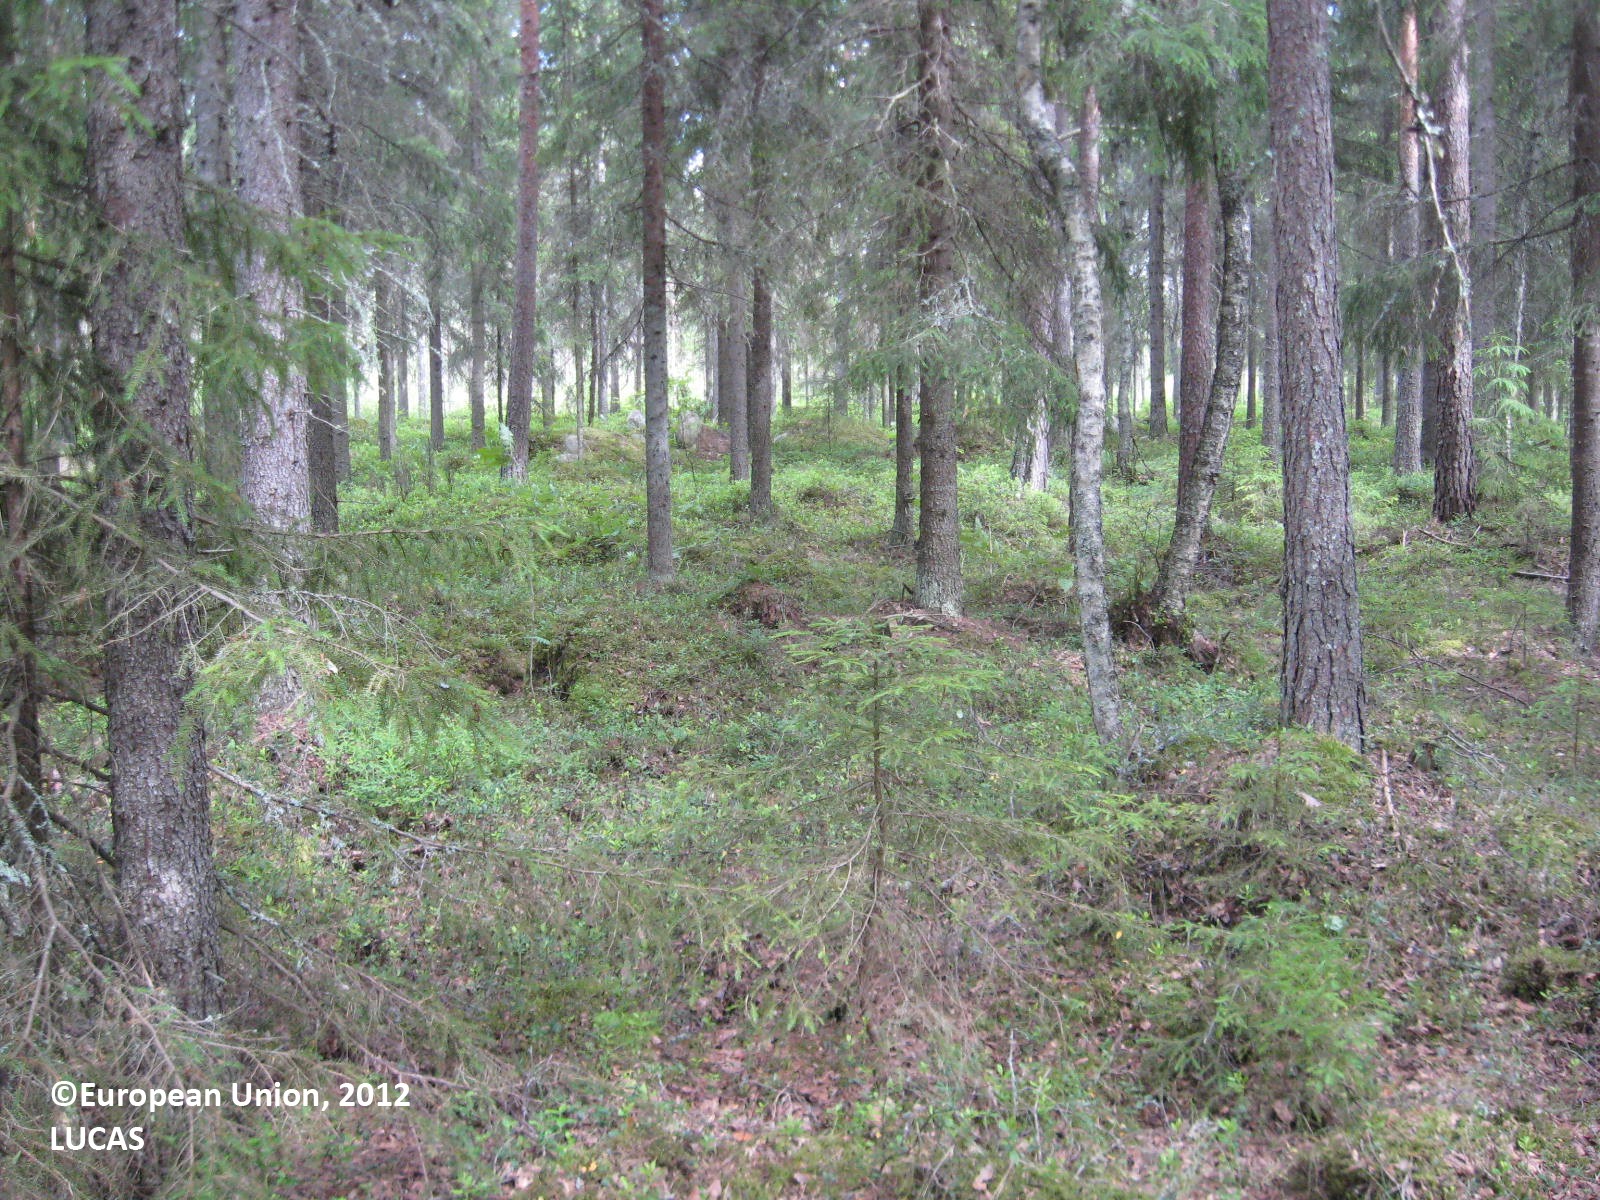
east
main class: Woodland
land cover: Other coniferous woodland
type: boreal forest
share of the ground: > 75 %
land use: Forestry
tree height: > 5 m
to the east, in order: Other coniferous woodland; Ditches and canals; Spruce dominated coniferous woodland; Pine dominated coniferous woodland
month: July
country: FI
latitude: 62.6656
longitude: 22.6078
